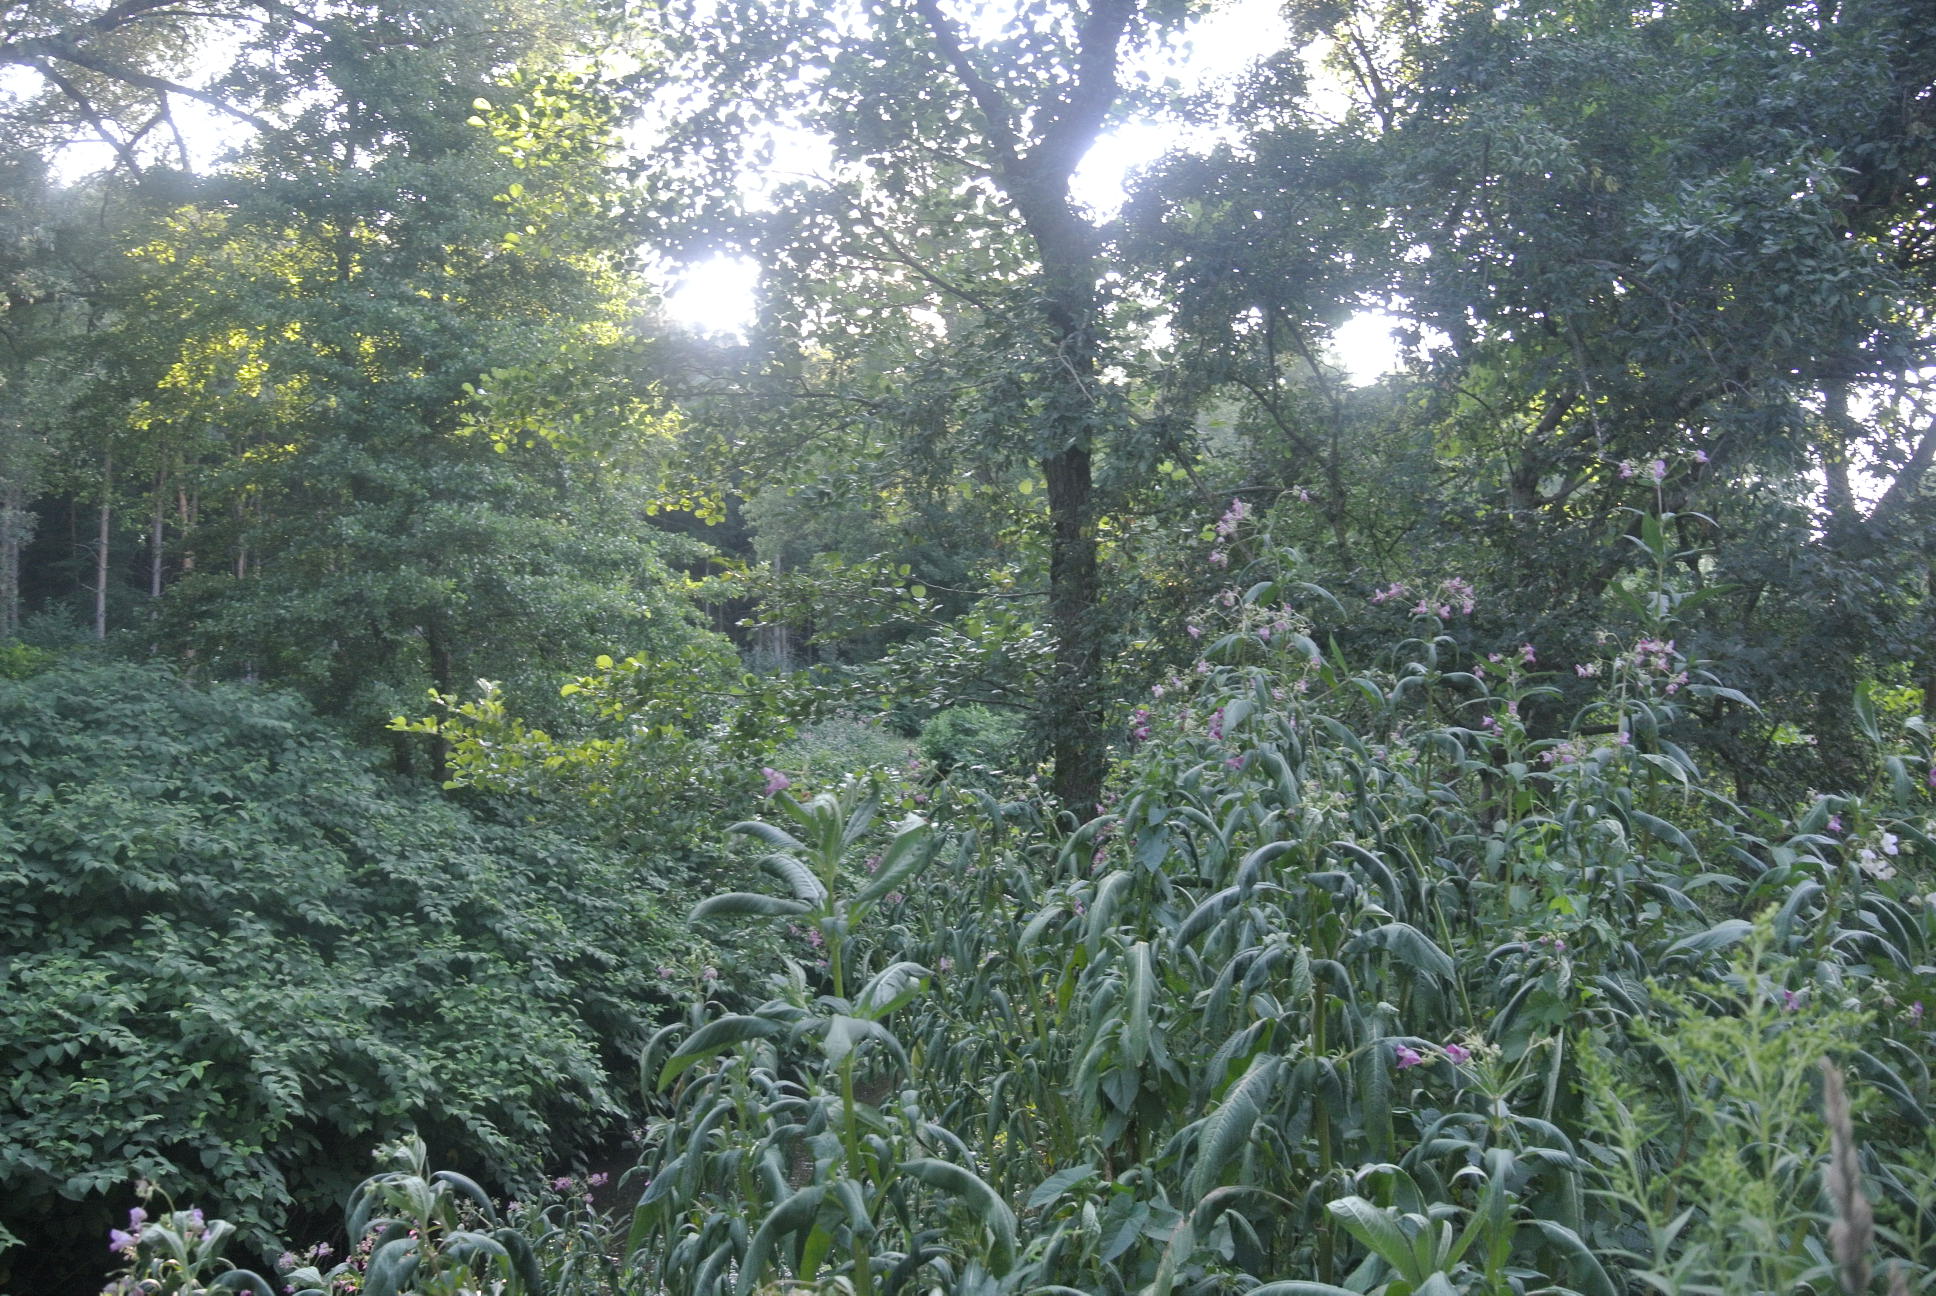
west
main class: Woodland
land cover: Broadleaved woodland
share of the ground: > 75 %
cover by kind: broadleaved forest trees 90 %, shrubs 5 %, herbaceous plants 5 %
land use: Forestry
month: July
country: AT
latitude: 47.5083
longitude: 16.4964
